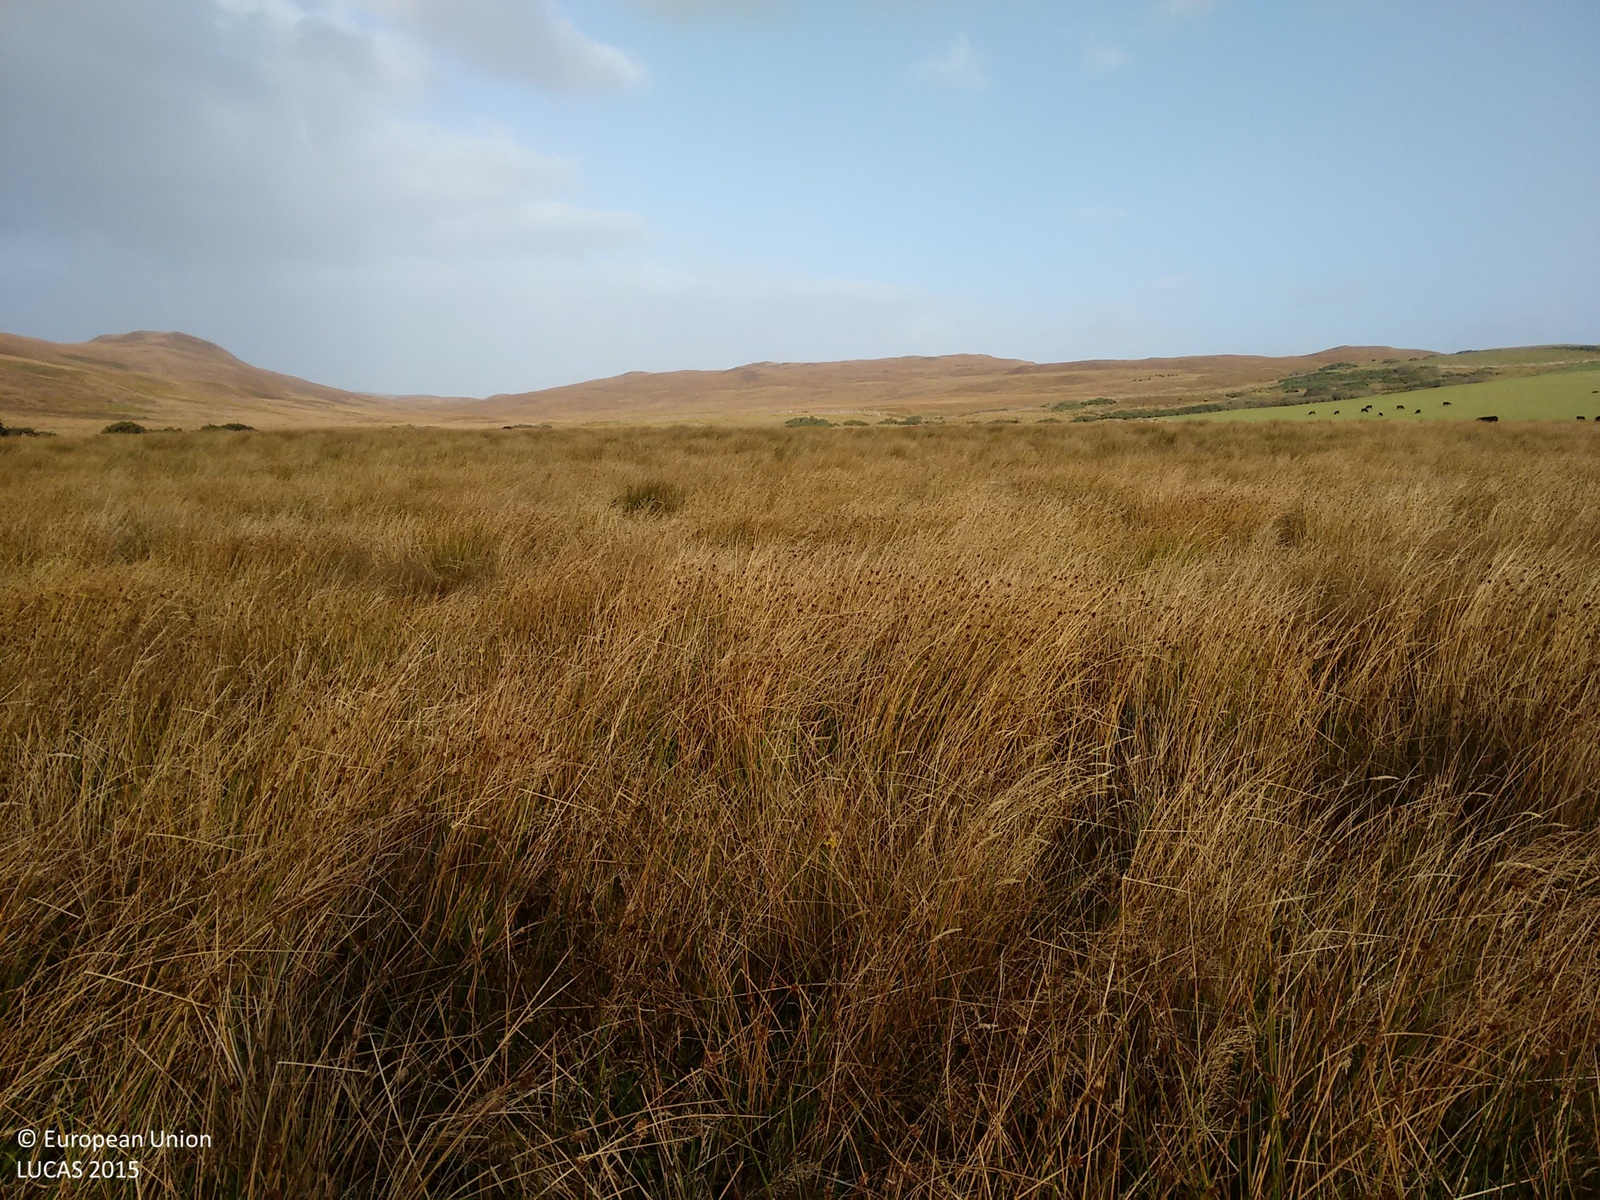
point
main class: Grassland
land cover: Grassland without tree/shrub cover
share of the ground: > 75 %
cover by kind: herbaceous plants 100 %
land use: Agriculture (excluding fallow land and kitchen gardens)
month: October
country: GB
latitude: 55.8045
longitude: -6.2412
